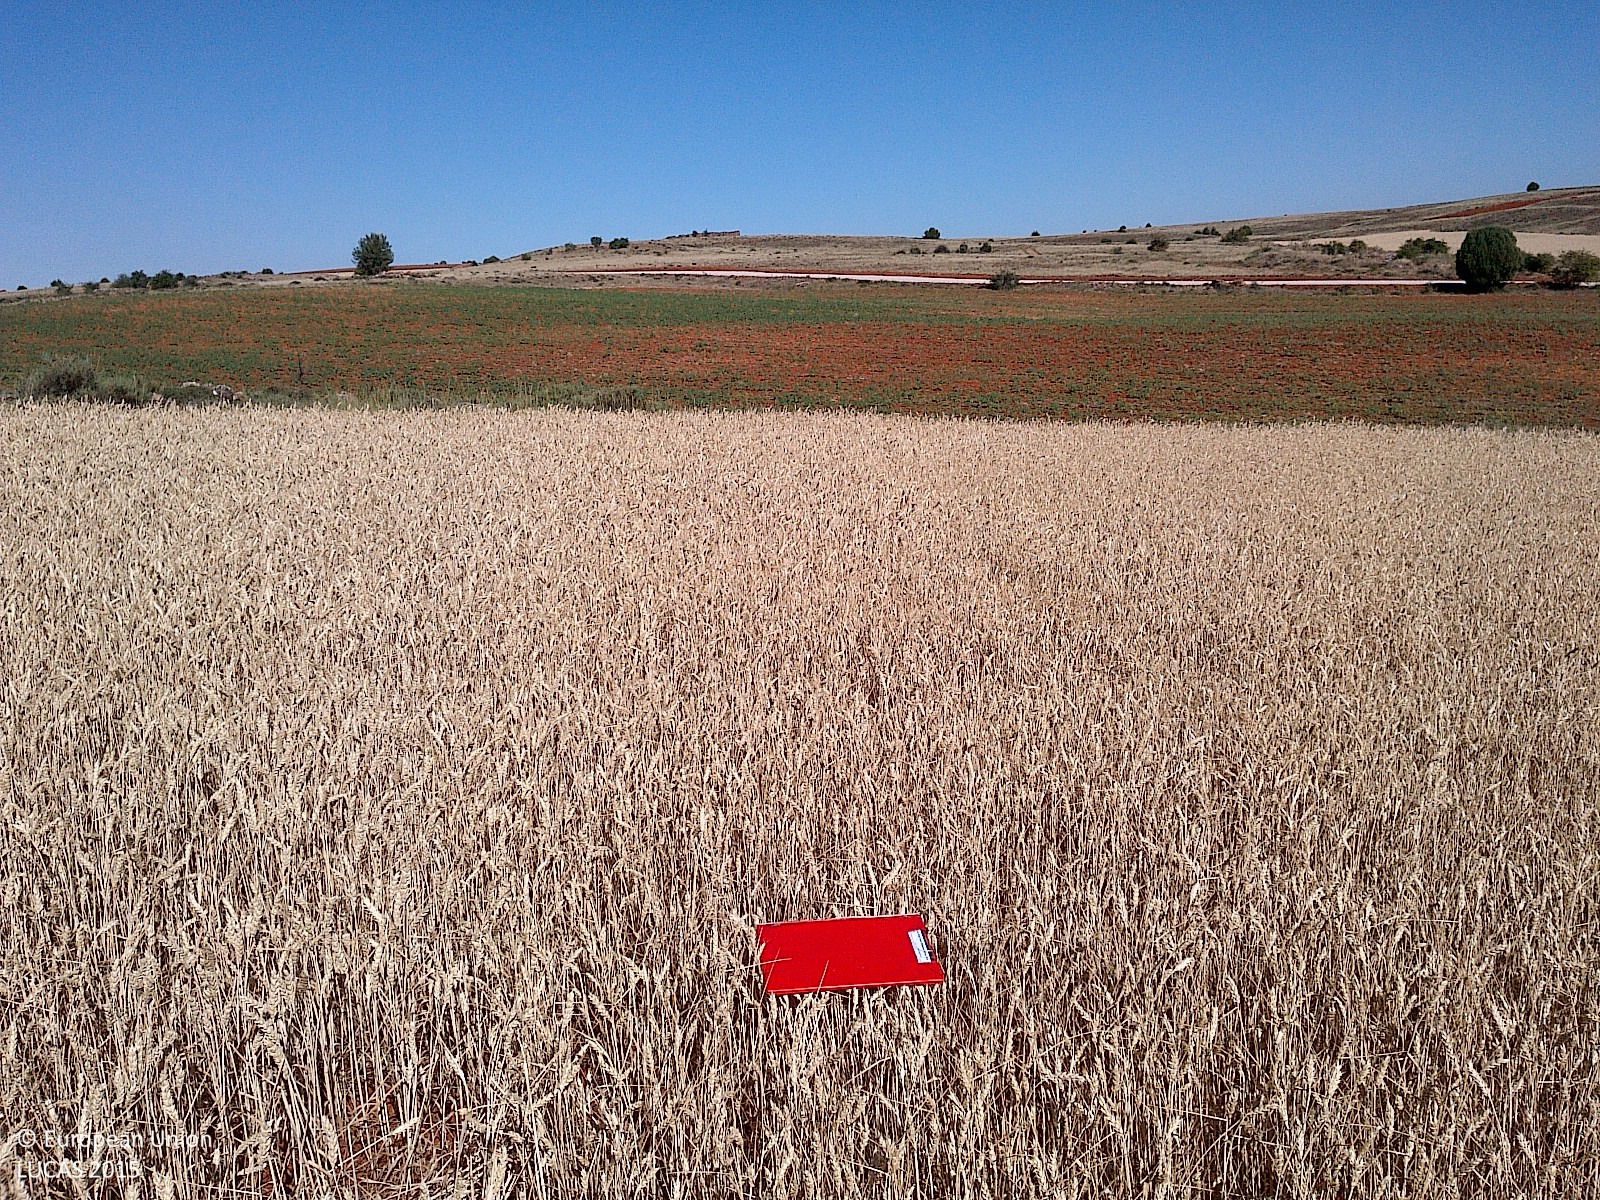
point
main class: Cropland
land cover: Common wheat
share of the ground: > 75 %
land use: Agriculture (excluding fallow land and kitchen gardens)
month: July
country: ES
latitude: 41.6579
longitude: -2.7818
